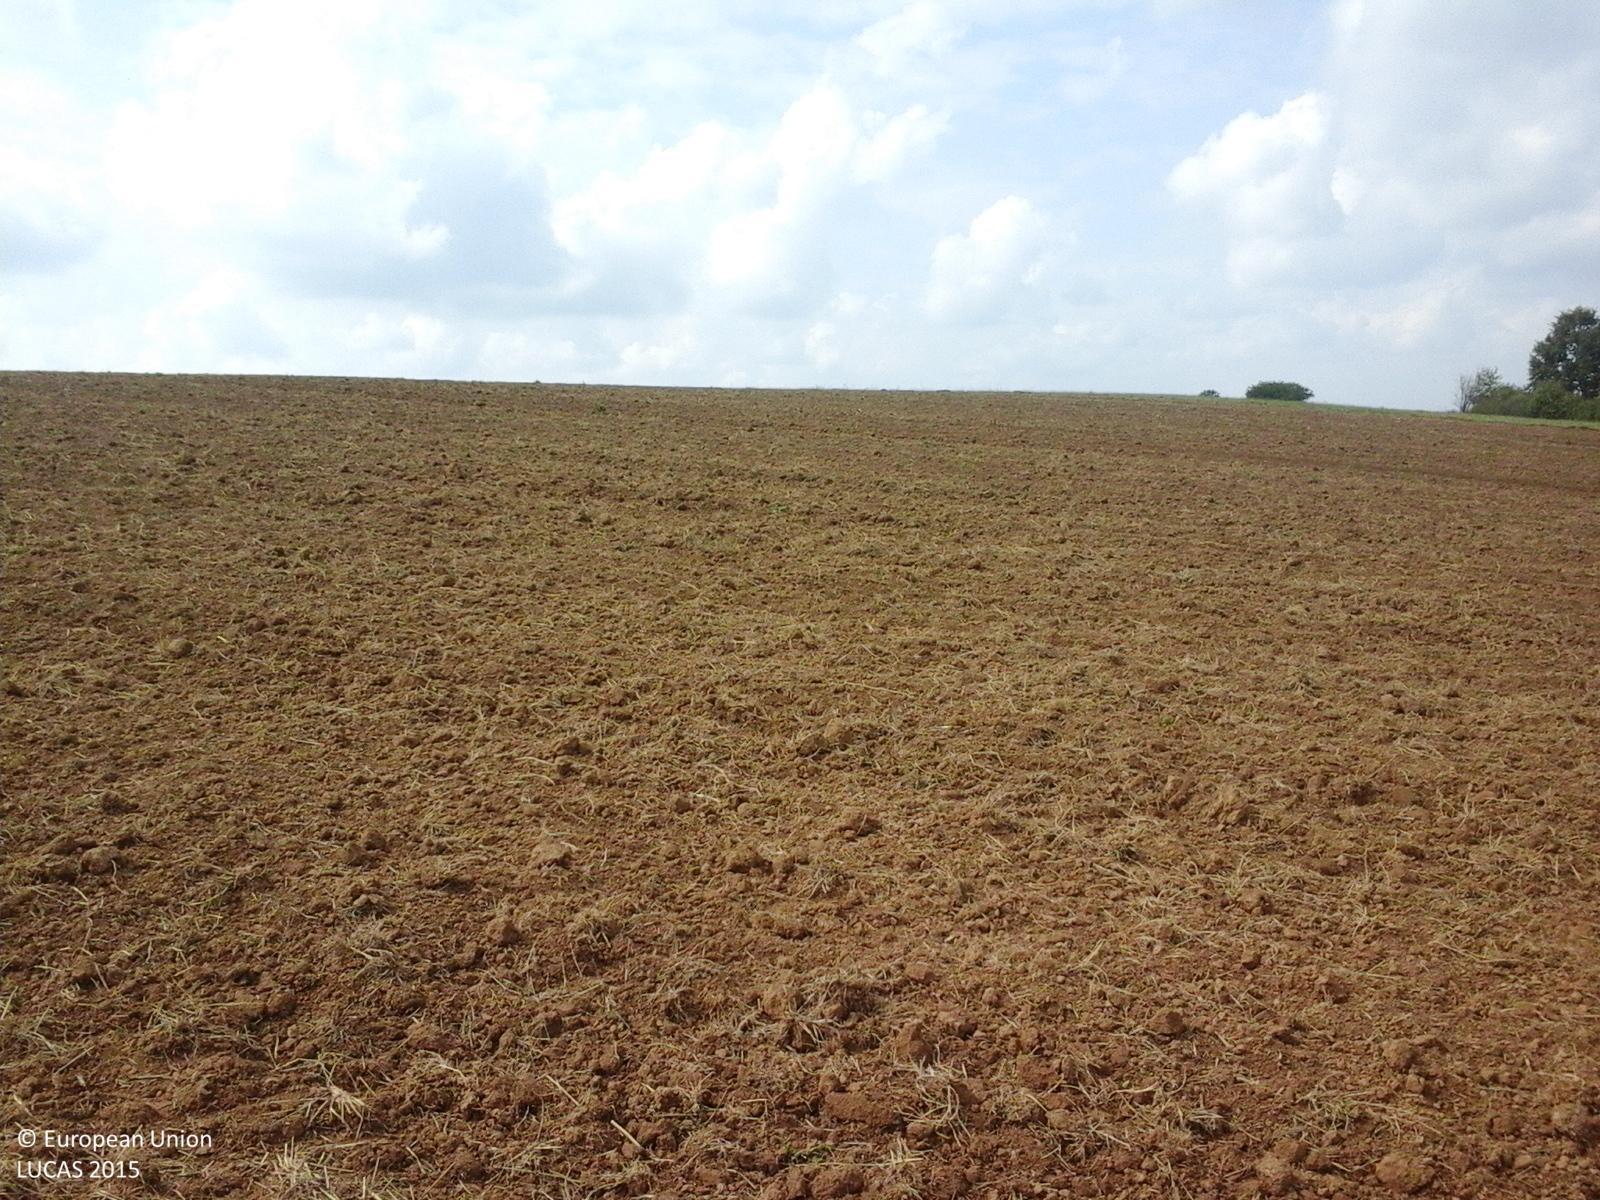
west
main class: Cropland
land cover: Maize
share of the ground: < 10 %
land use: Agriculture (excluding fallow land and kitchen gardens)
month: September
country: RO
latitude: 46.8770
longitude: 21.9731
